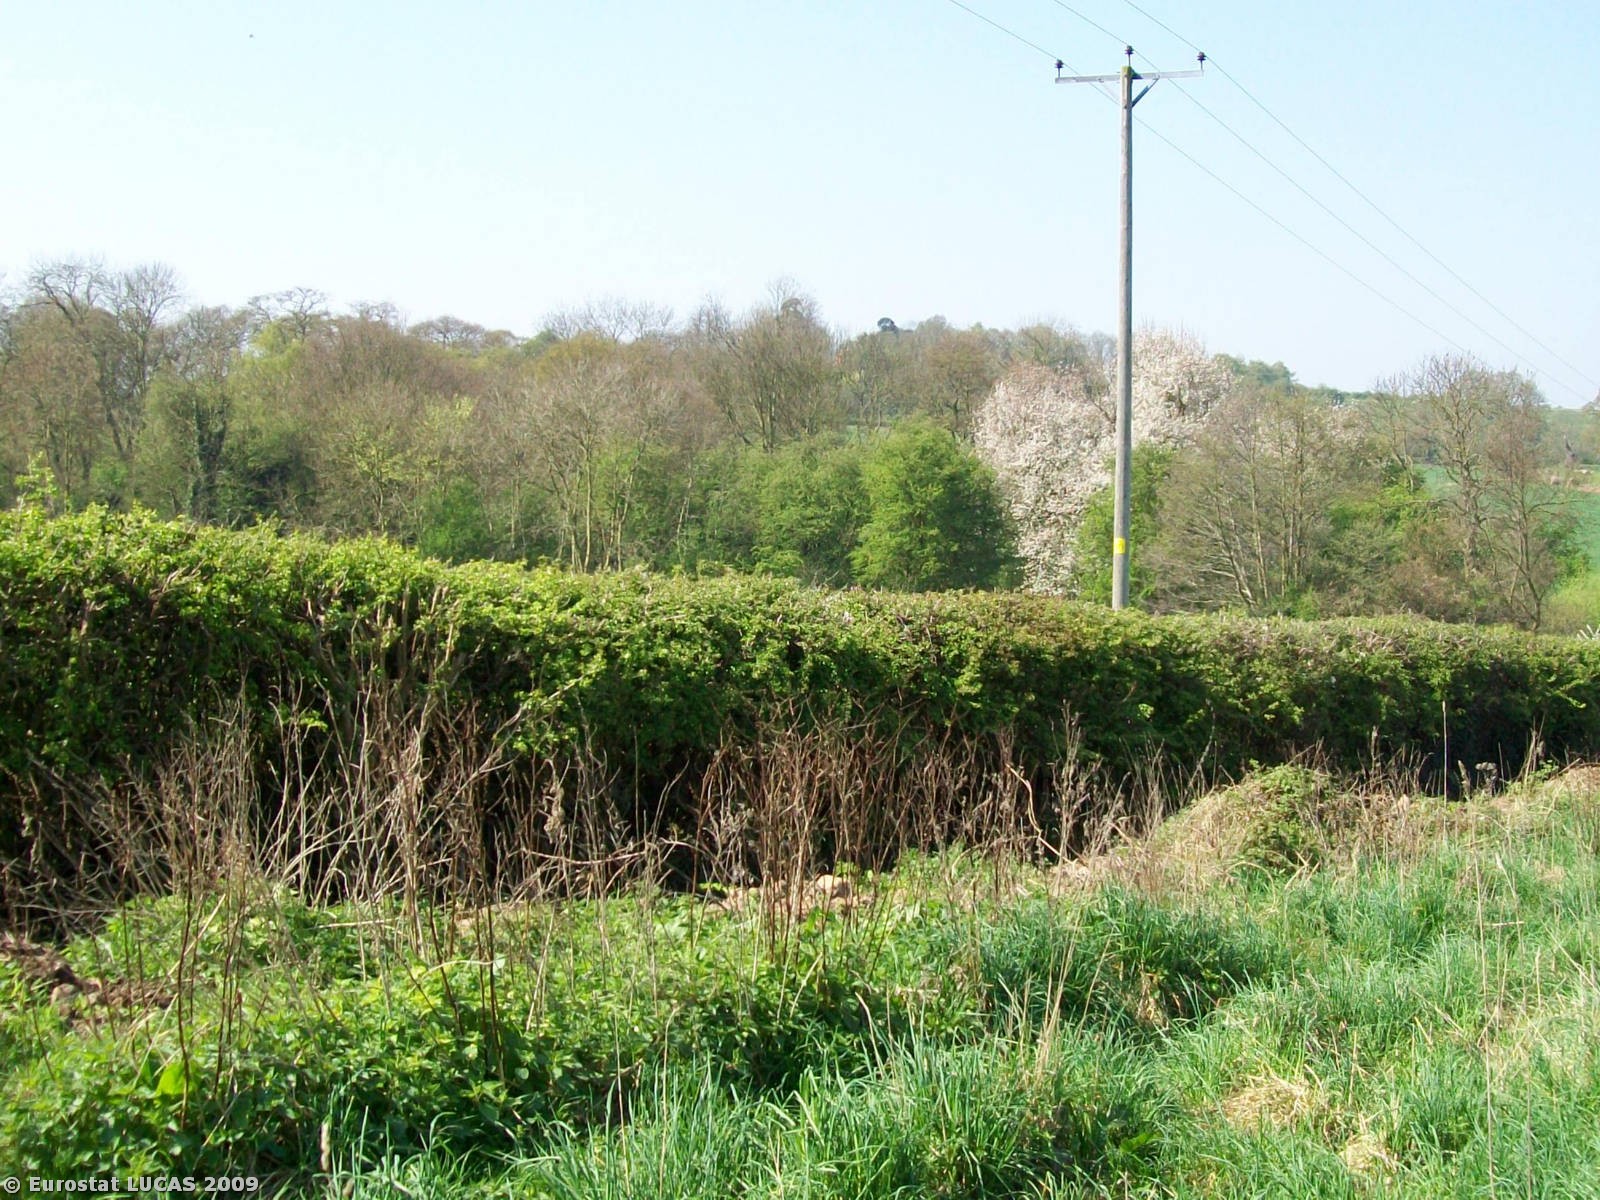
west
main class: Cropland
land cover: Rape and turnip rape
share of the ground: > 75 %
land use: Agriculture (excluding fallow land and kitchen gardens)
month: April
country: GB
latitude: 52.8371
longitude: -1.4658
